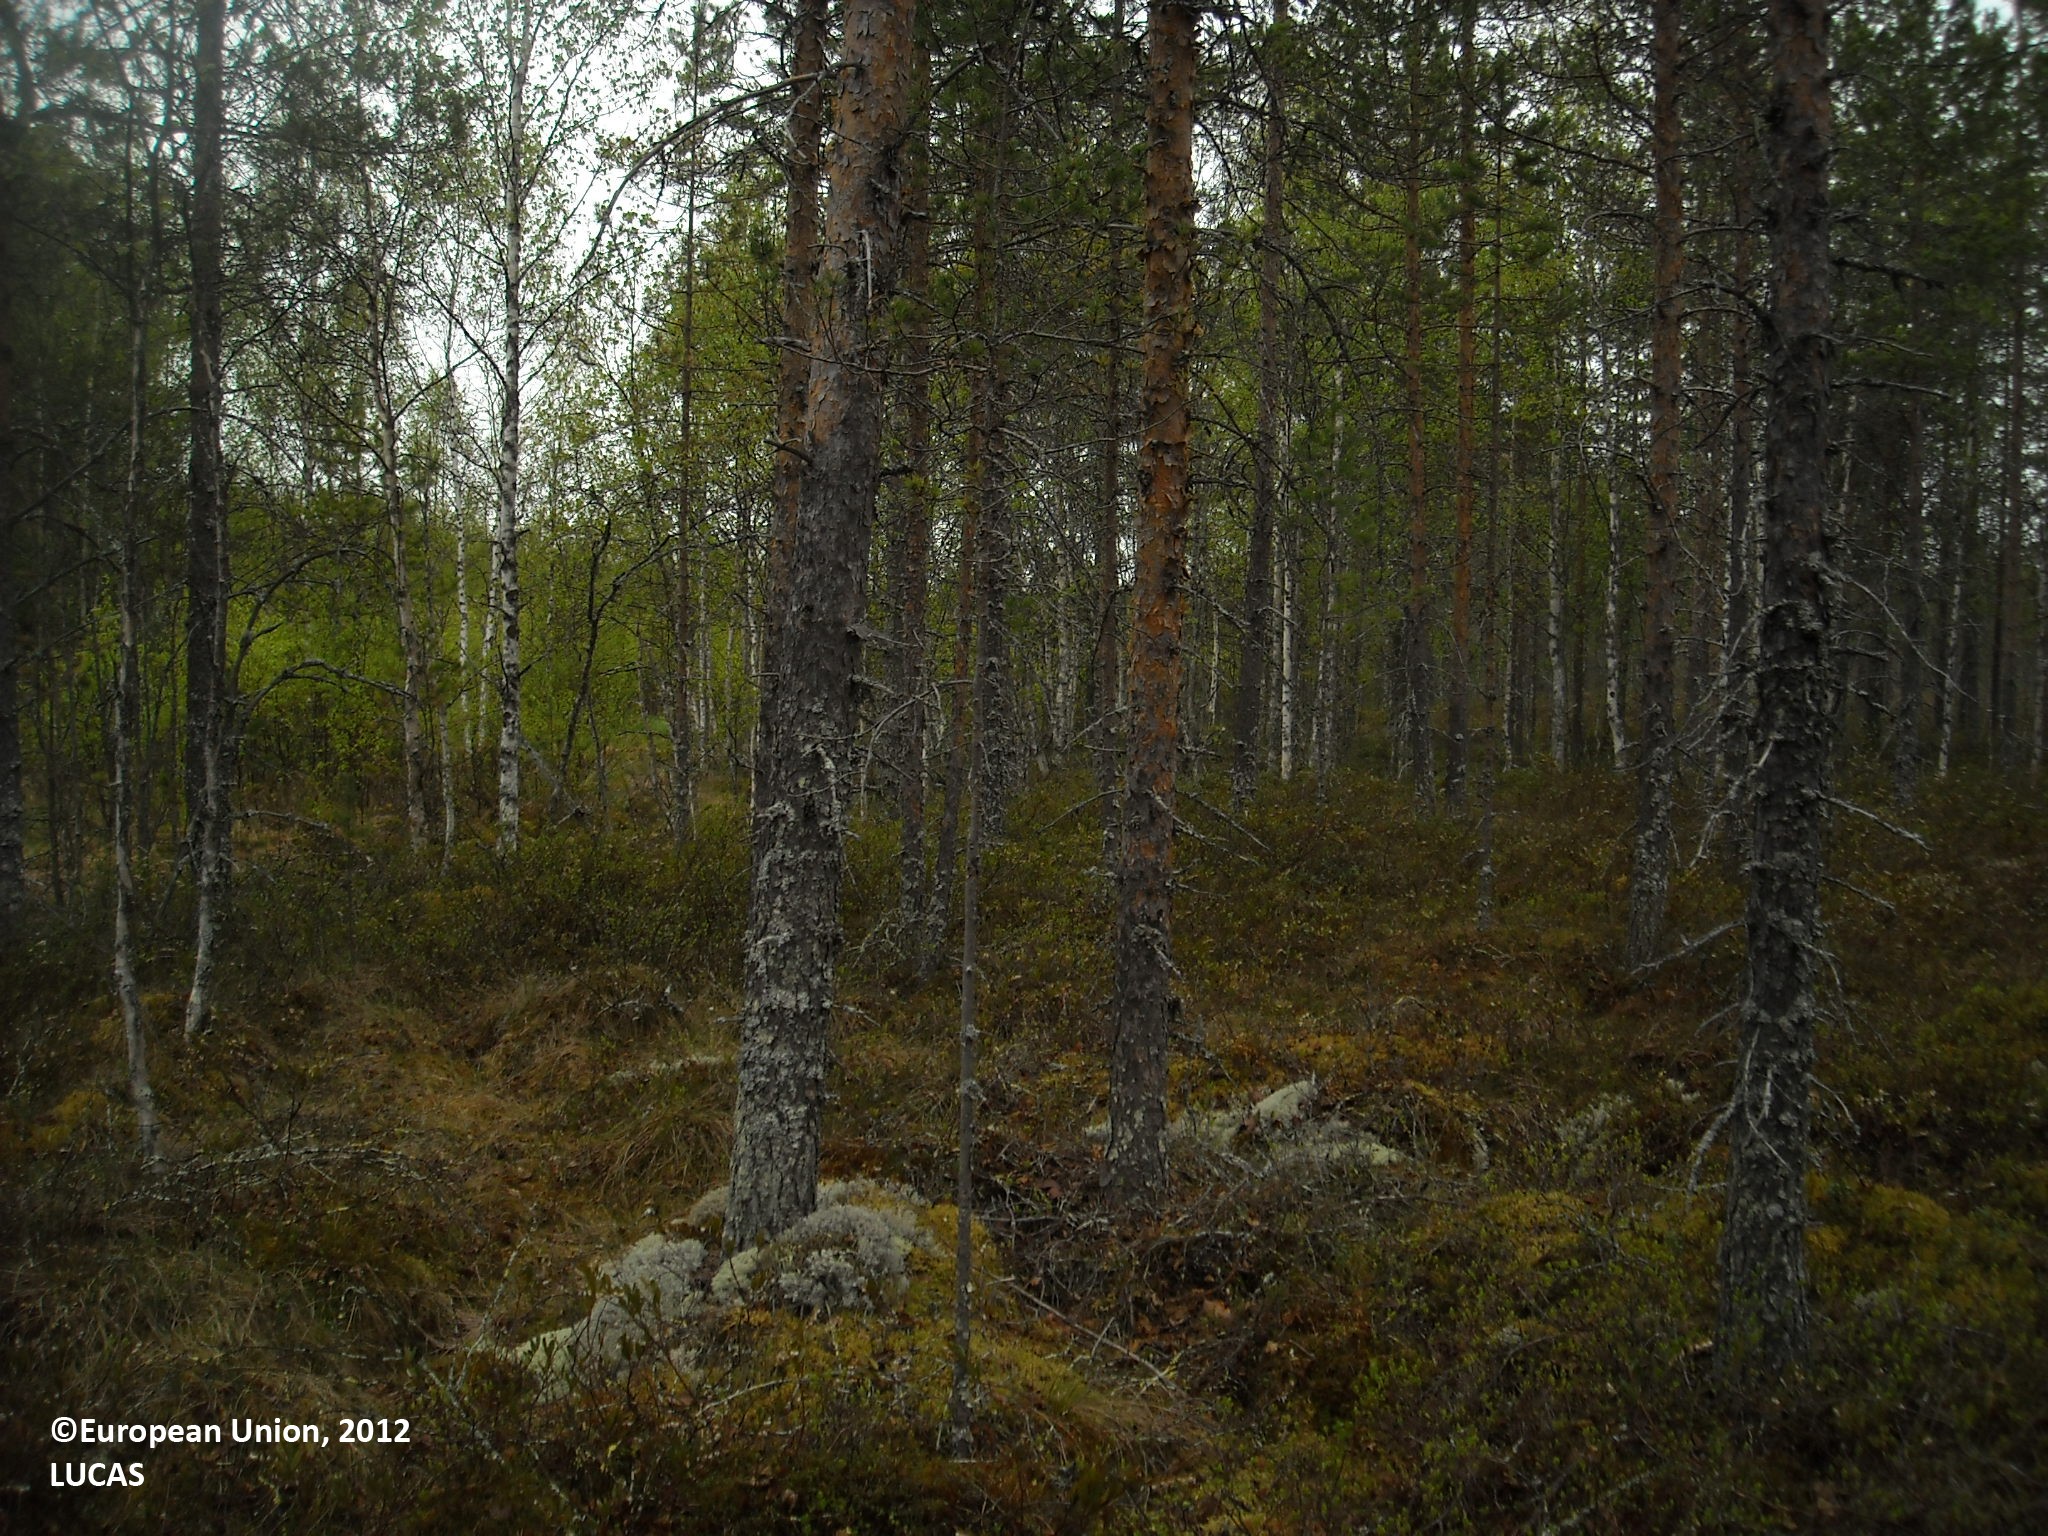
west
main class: Woodland
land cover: Pine dominated coniferous woodland
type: mire and swamp forests
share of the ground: > 75 %
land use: Forestry
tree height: > 5 m
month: June
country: FI
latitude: 64.5999
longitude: 27.2039
